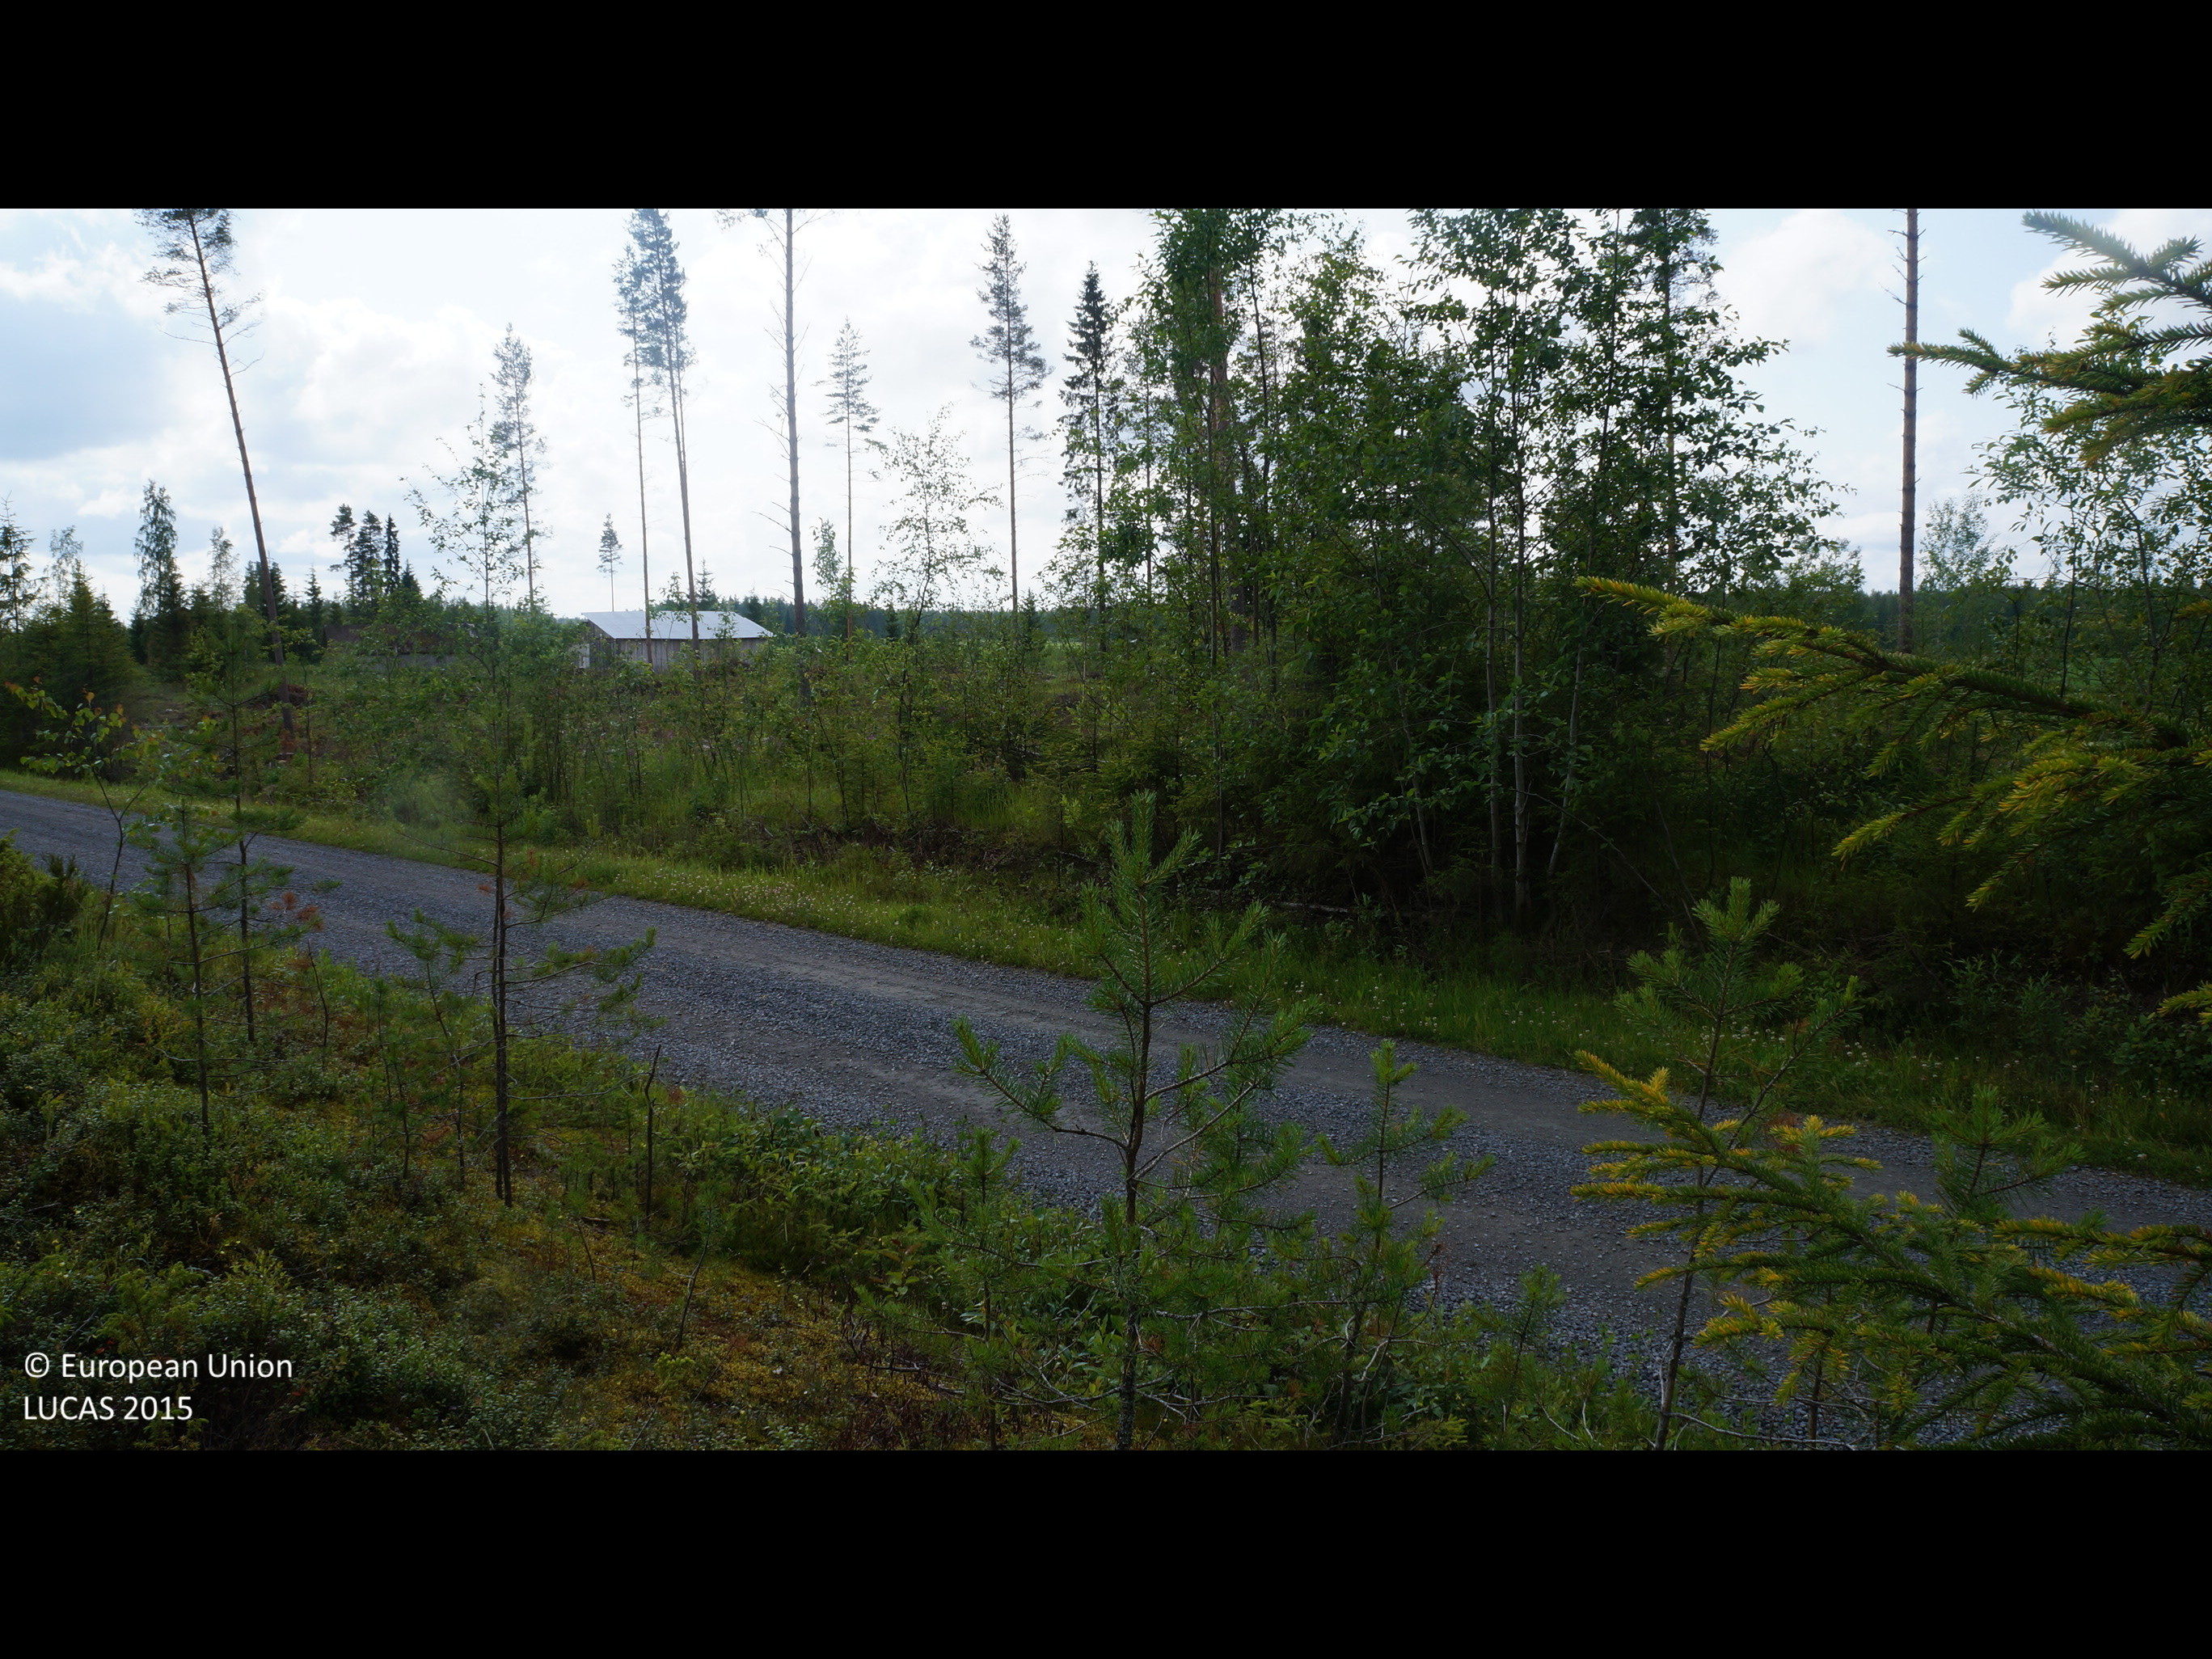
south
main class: Woodland
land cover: Pine dominated coniferous woodland
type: boreal forest
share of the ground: 10 - 25 %
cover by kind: shrubs 80 %, coniferous forest trees 10 %, herbaceous plants 5 %, lichens and mosses 5 %
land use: Forestry
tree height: > 5 m
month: July
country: FI
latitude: 64.1110
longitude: 24.3368
